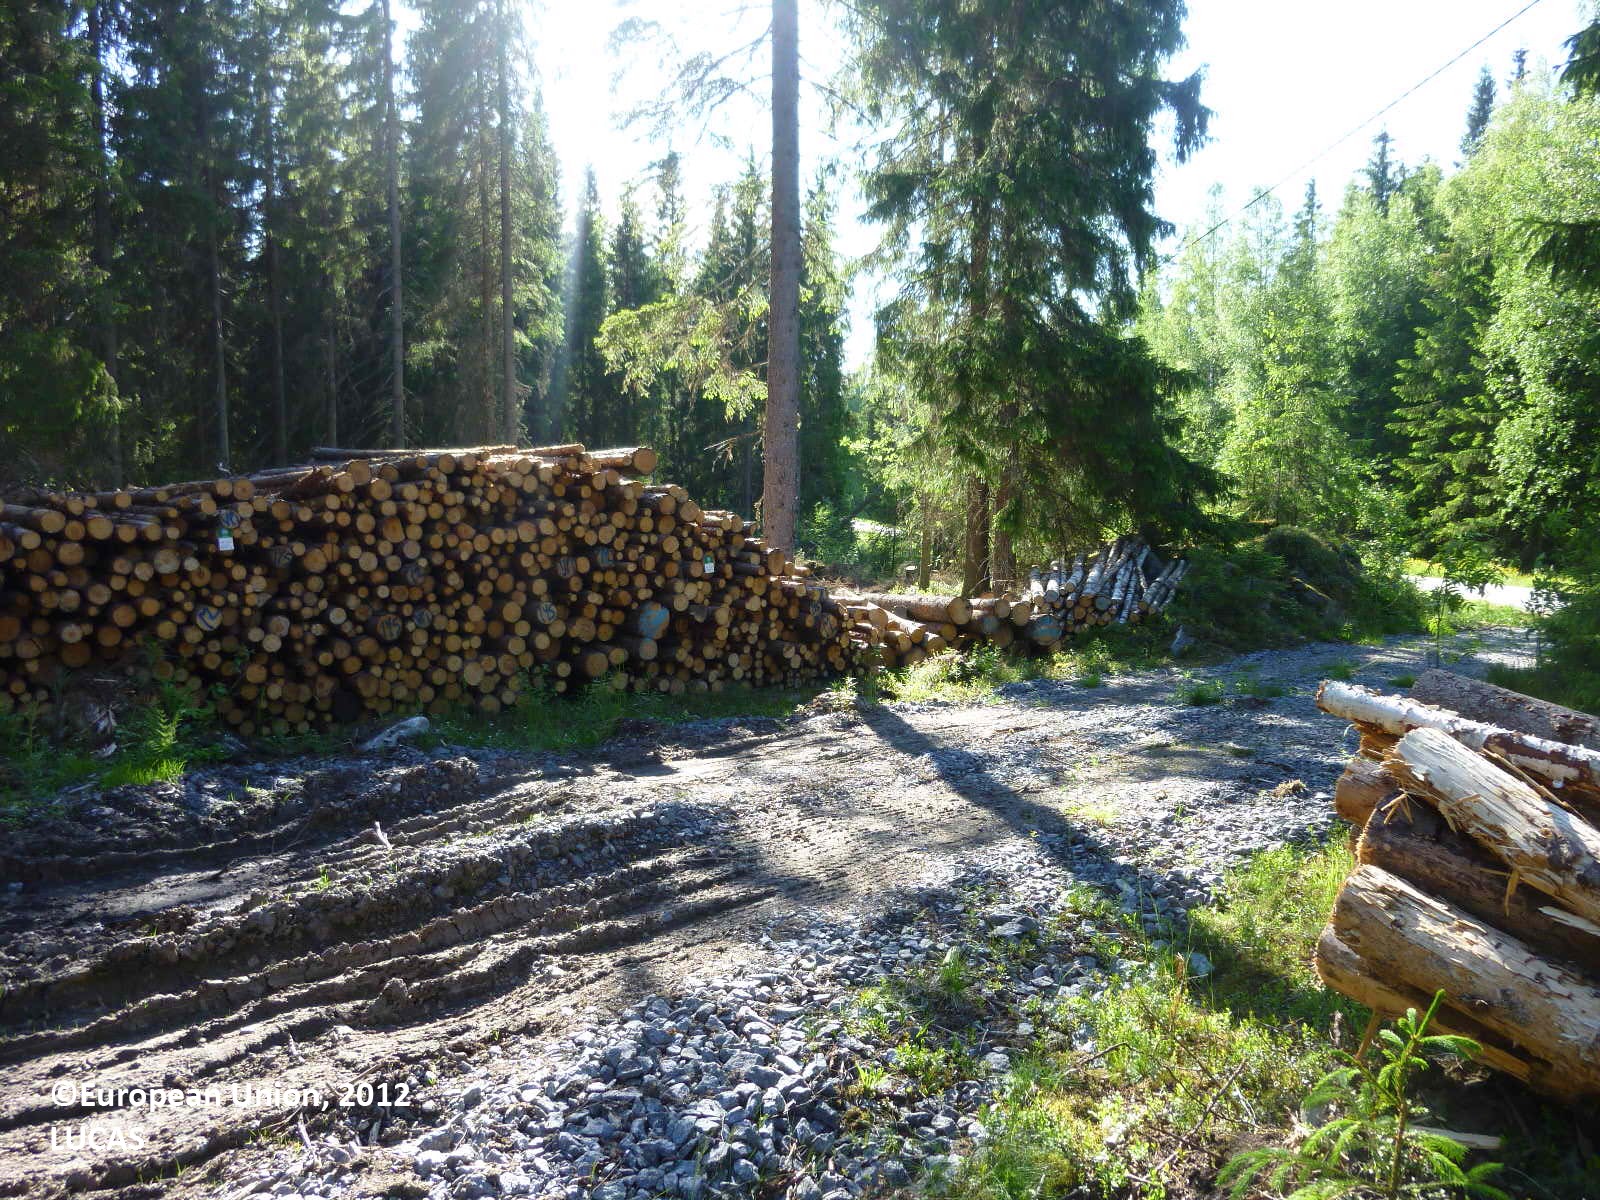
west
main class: Woodland
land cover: Spruce dominated coniferous woodland
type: boreal forest
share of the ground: > 75 %
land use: Forestry
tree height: > 5 m
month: June
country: FI
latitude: 61.6719
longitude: 22.2433
